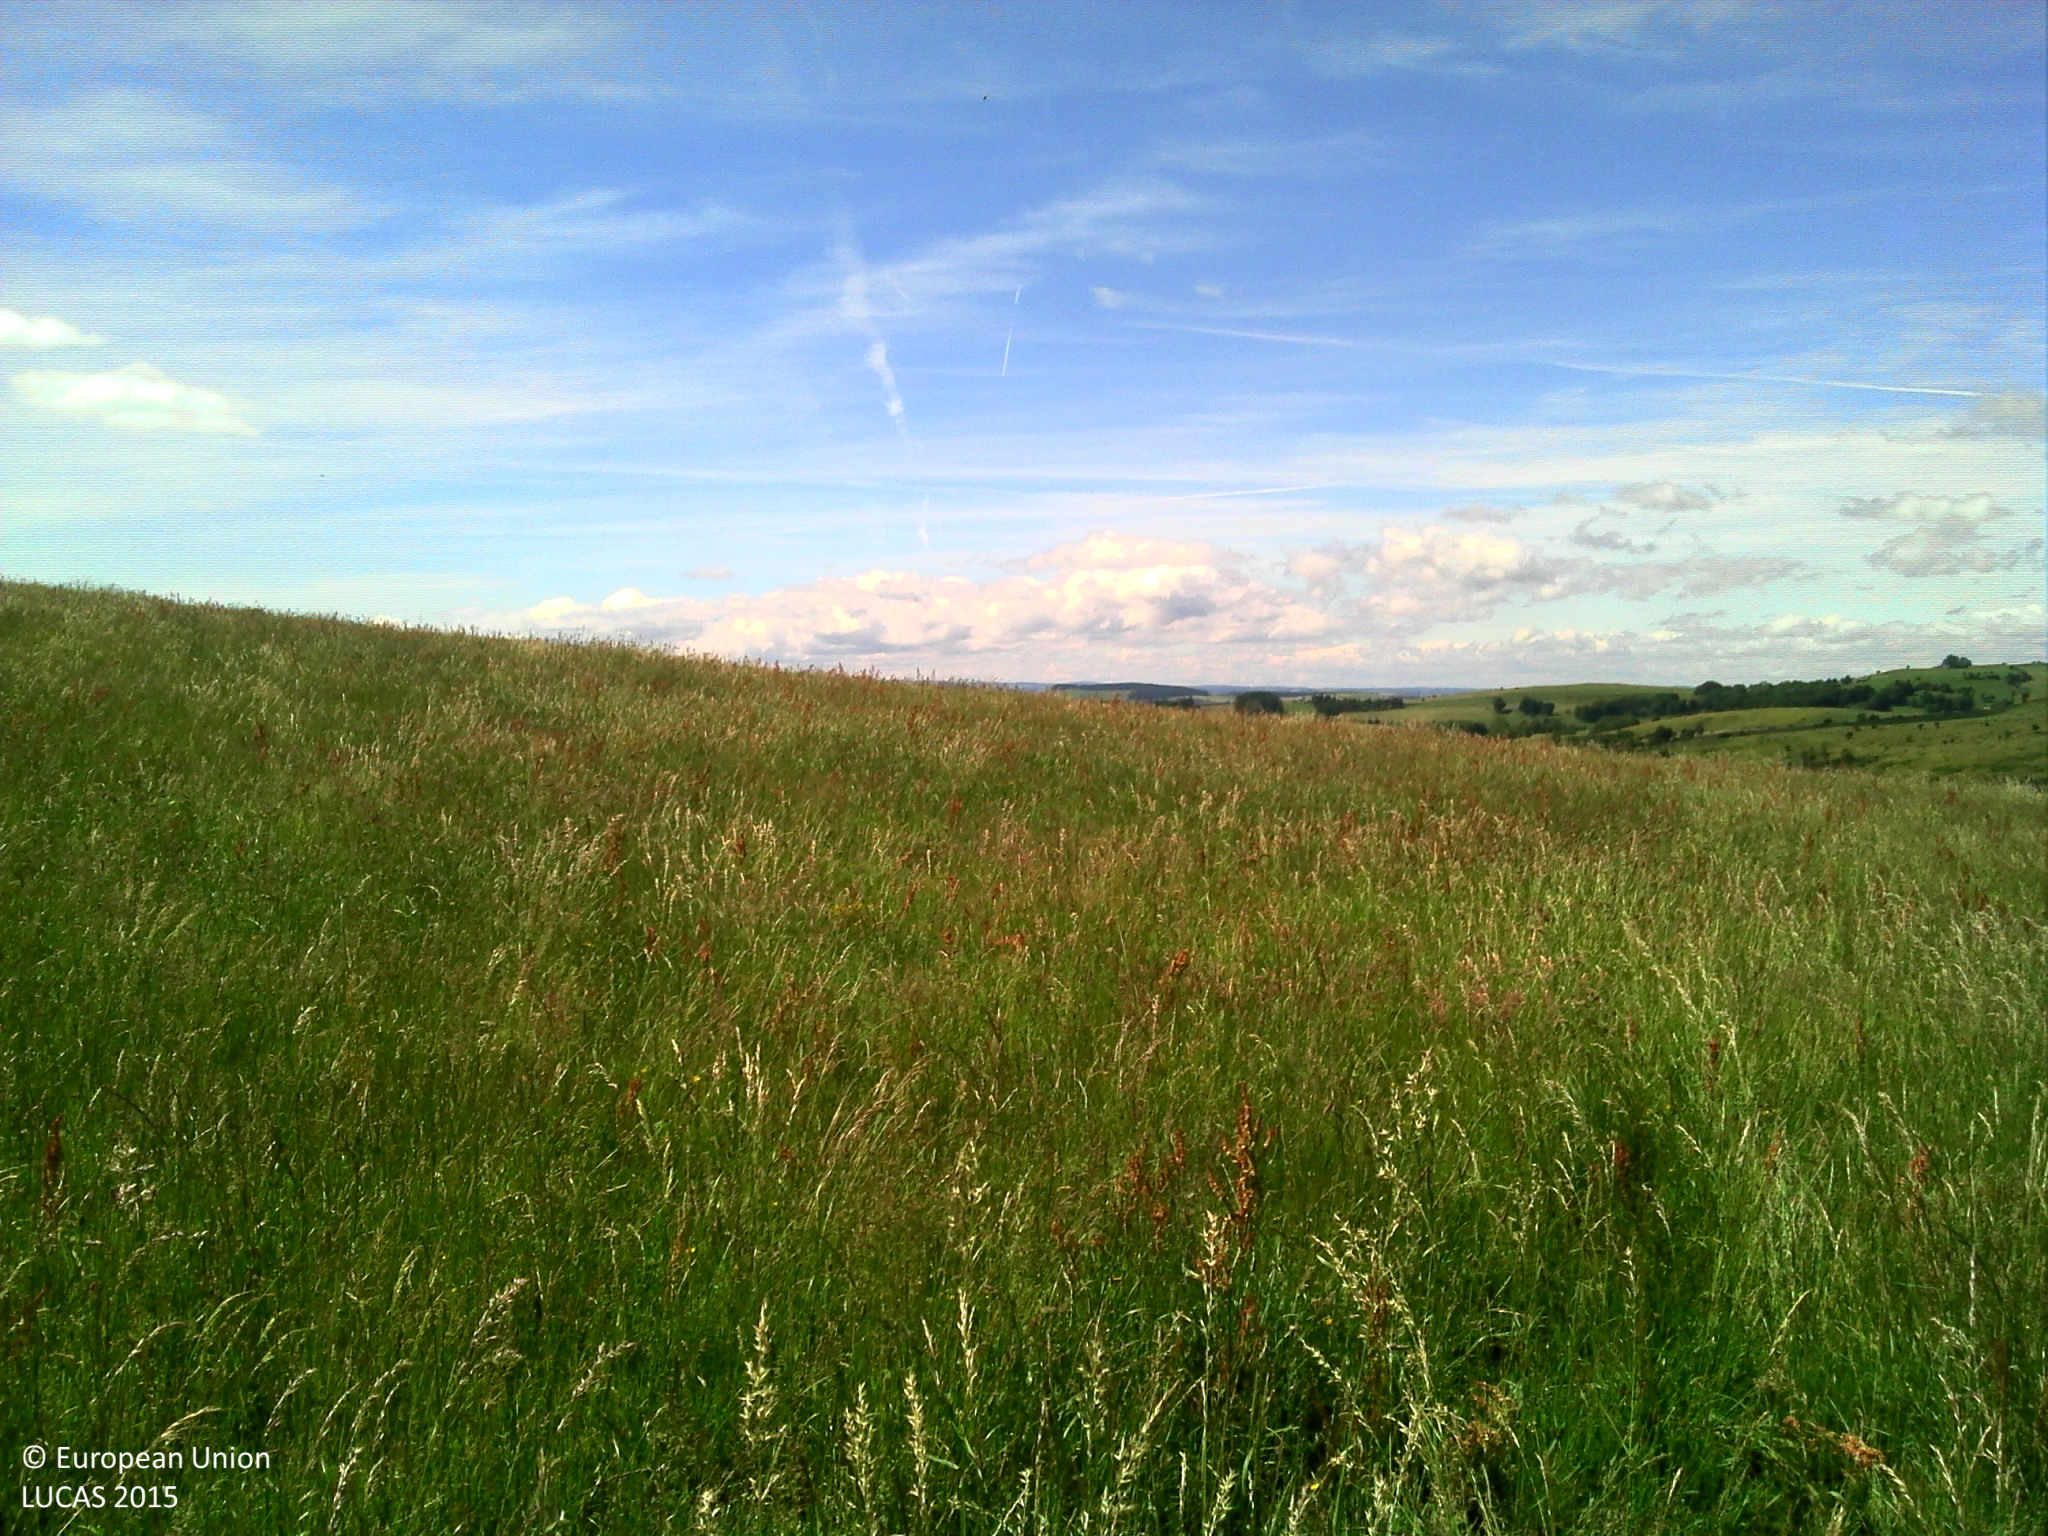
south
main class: Grassland
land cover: Grassland without tree/shrub cover
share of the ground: > 75 %
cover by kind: herbaceous plants 100 %
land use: Agriculture (excluding fallow land and kitchen gardens)
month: June
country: FR
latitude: 45.0109
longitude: 2.8836
